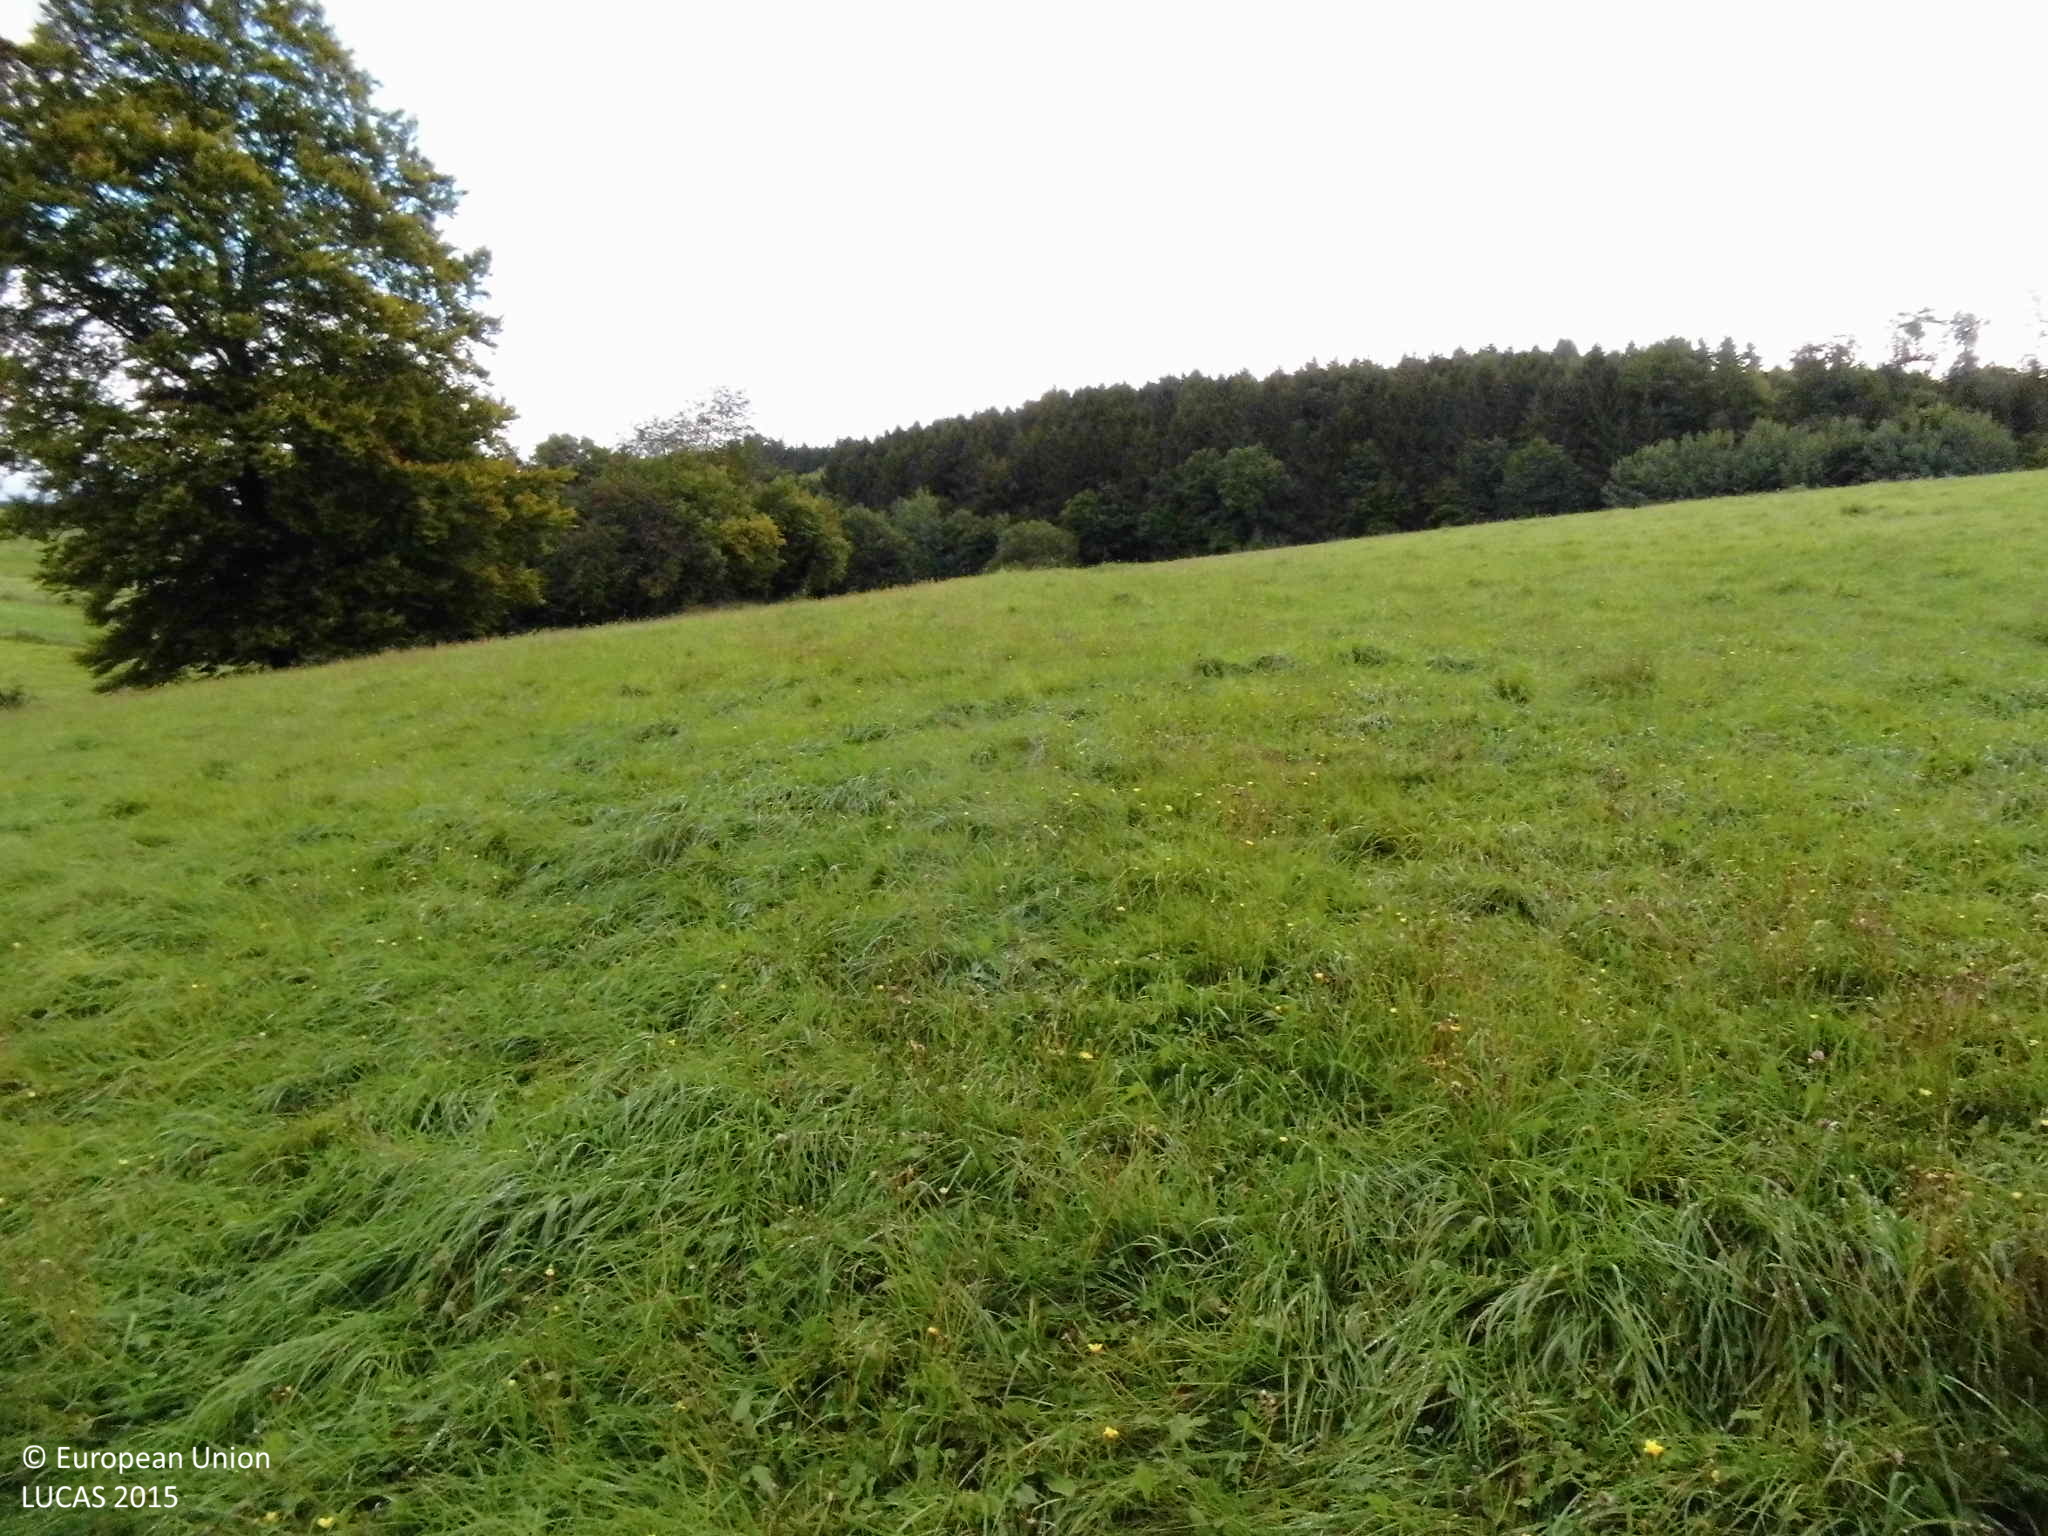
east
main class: Grassland
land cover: Grassland without tree/shrub cover
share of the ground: > 75 %
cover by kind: herbaceous plants 100 %
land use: Agriculture (excluding fallow land and kitchen gardens)
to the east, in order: Grassland without tree/shrub cover; Fences; Grassland without tree/shrub cover; Rivers and streams; Grassland without tree/shrub cover; Fences; Broadleaved woodland; Fences; Shruby margins; Tracks; Groves; Spruce dominated coniferous woodland
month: September
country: DE
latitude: 50.6592
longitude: 7.4398
